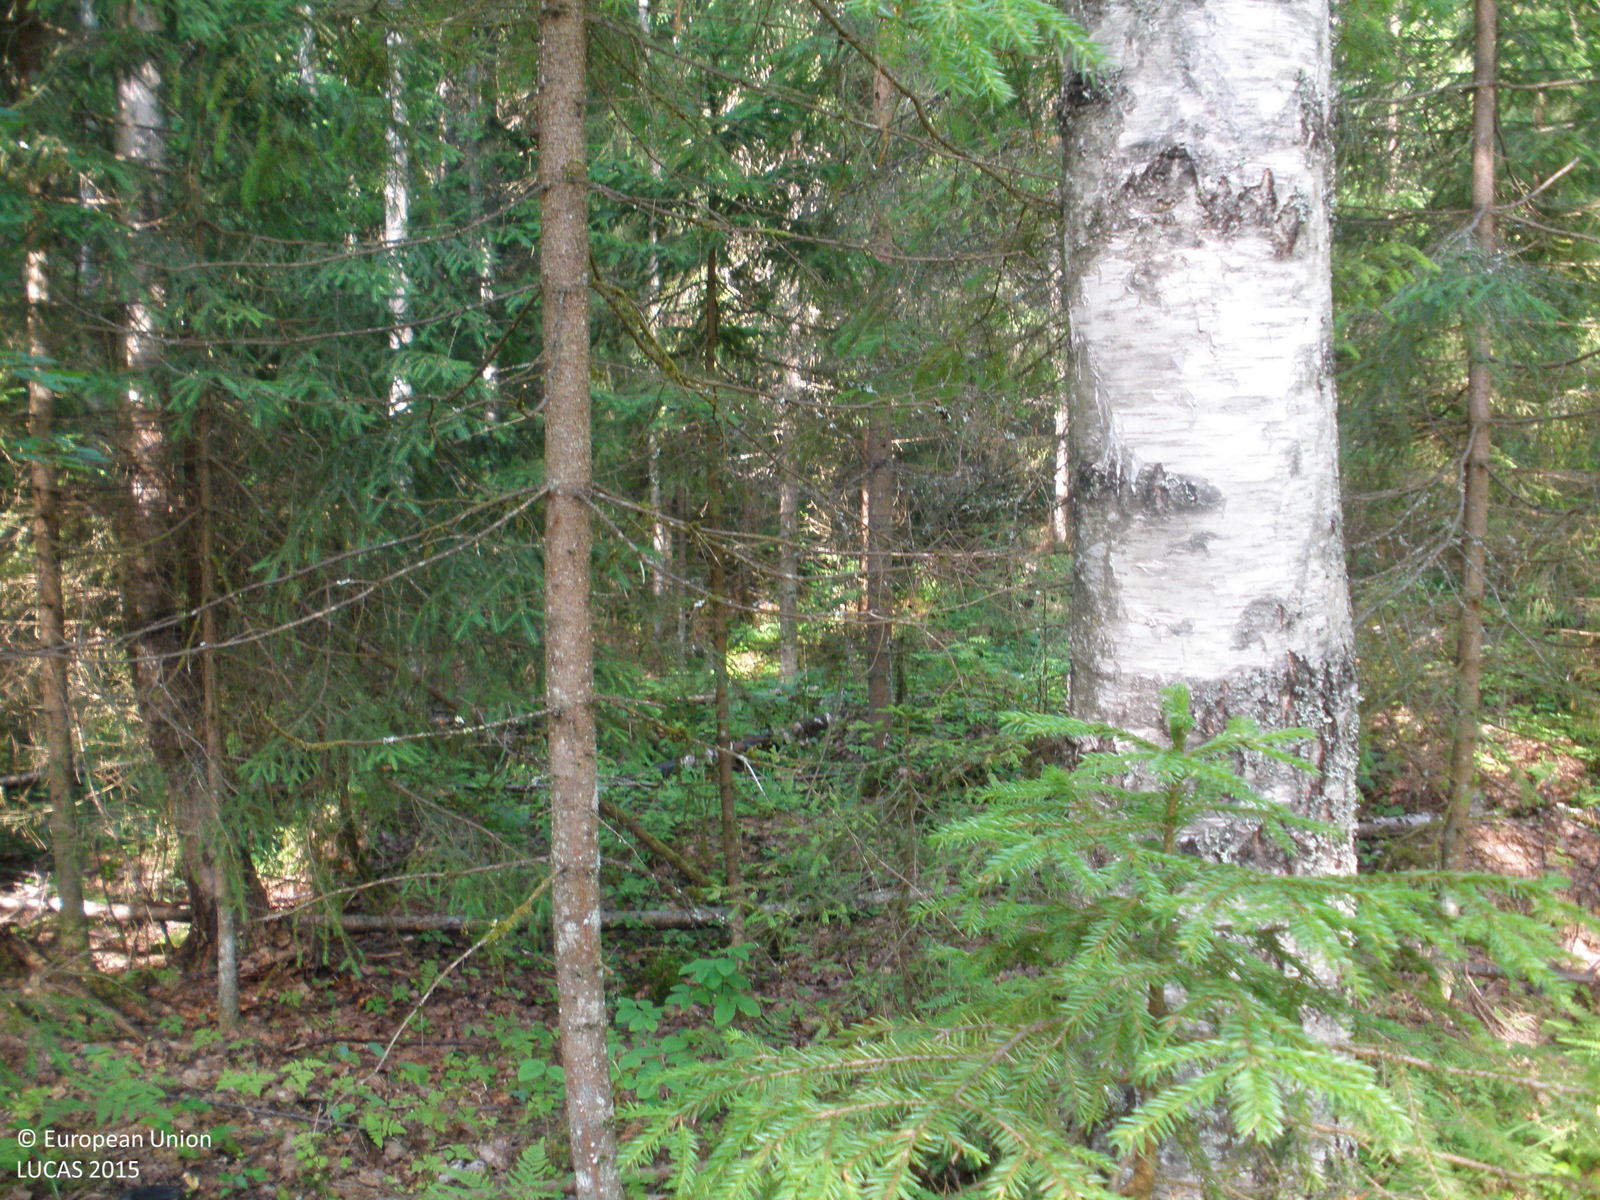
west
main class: Woodland
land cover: Spruce dominated mixed woodland
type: boreal forest
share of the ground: > 75 %
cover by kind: broadleaved forest trees 55 %, coniferous forest trees 30 %, herbaceous plants 10 %, shrubs 5 %
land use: Forestry
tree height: > 5 m
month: July
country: FI
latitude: 61.4379
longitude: 23.8291
